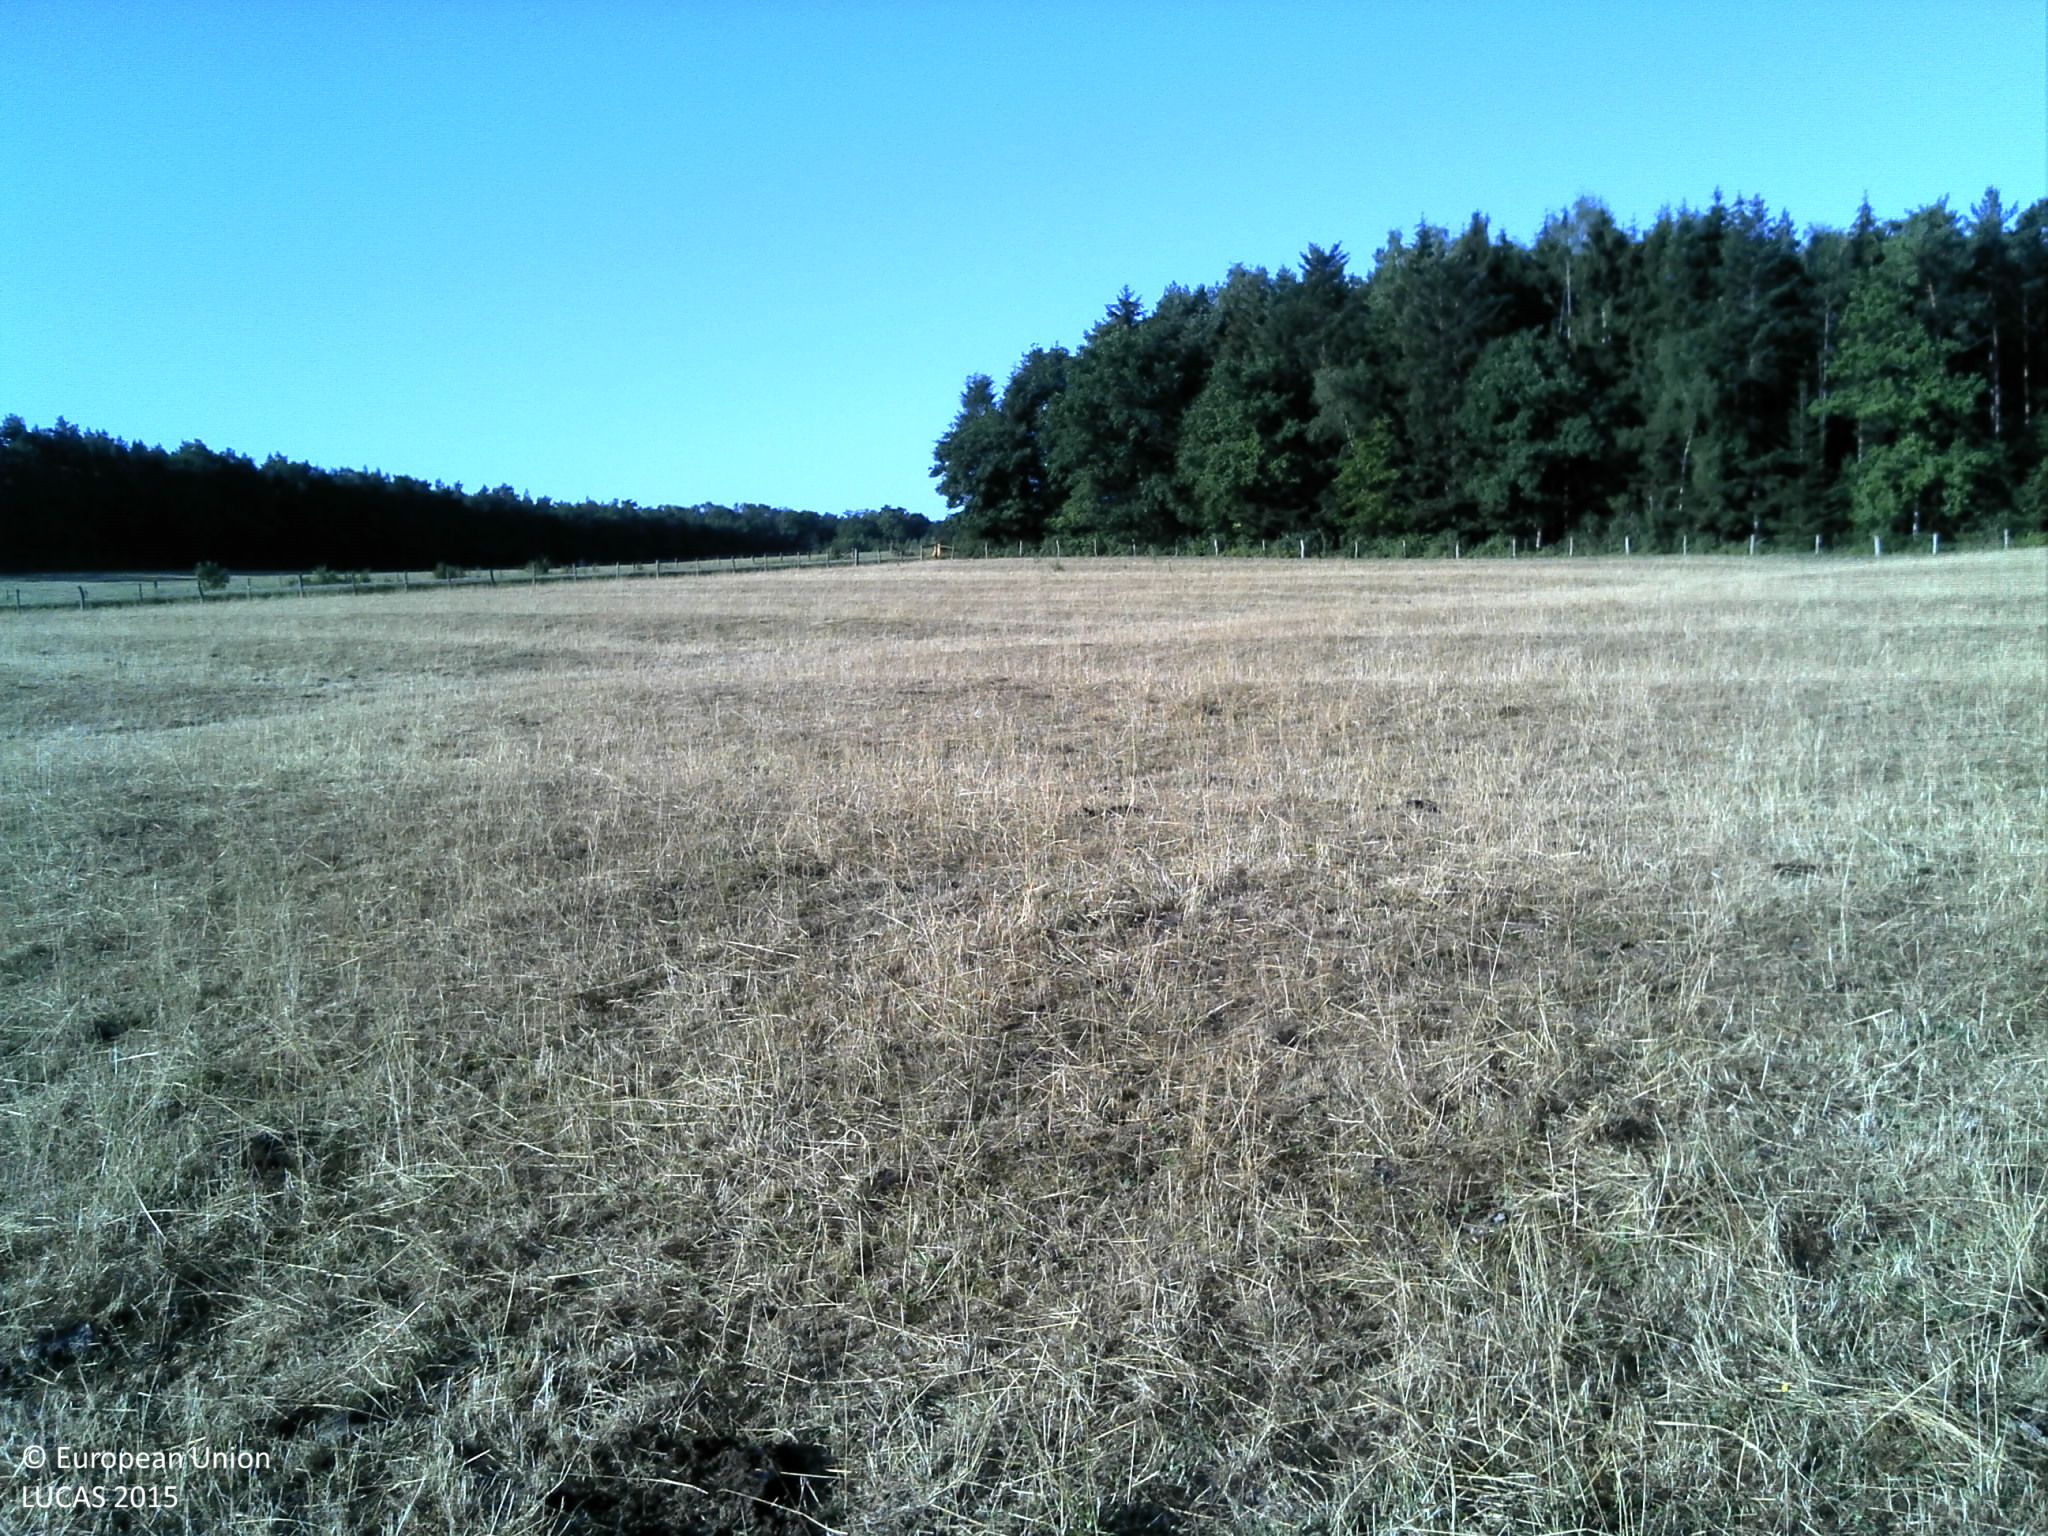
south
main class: Grassland
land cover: Grassland without tree/shrub cover
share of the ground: > 75 %
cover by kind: herbaceous plants 100 %
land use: Agriculture (excluding fallow land and kitchen gardens)
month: July
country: FR
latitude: 48.2279
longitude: 6.1369
